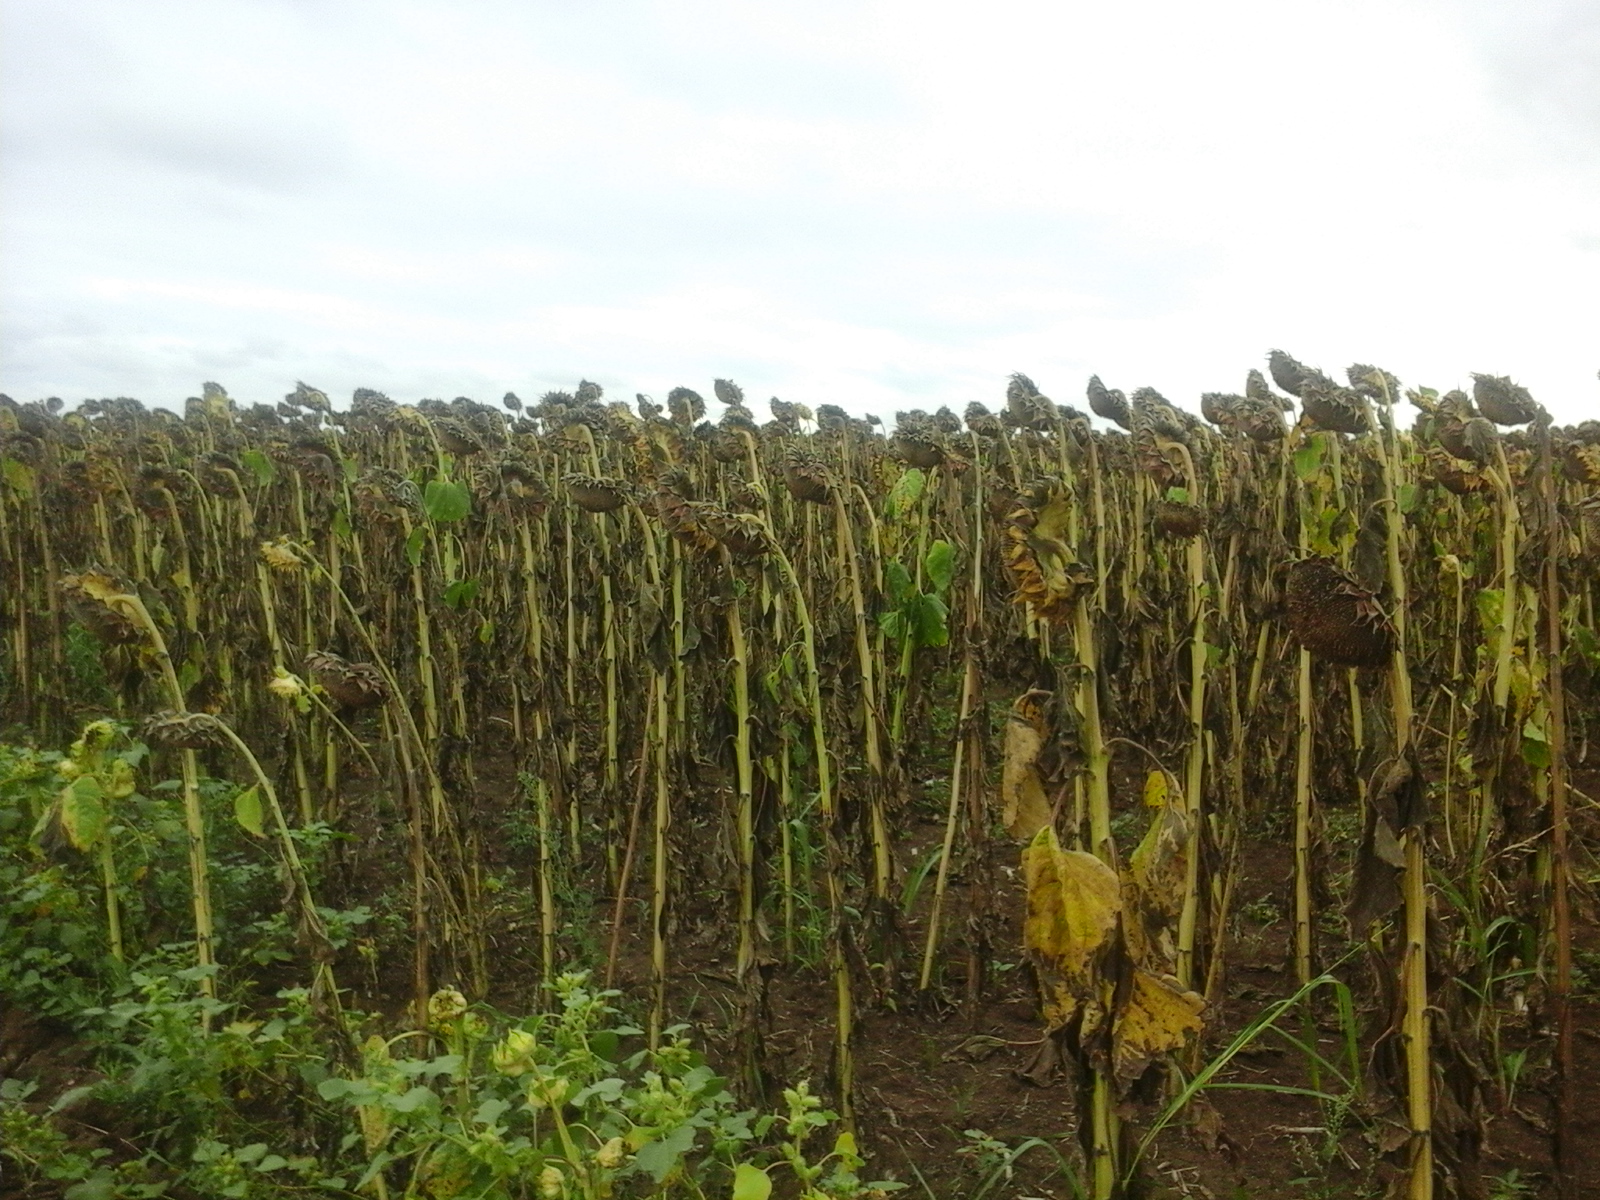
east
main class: Cropland
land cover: Sunflower
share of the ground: > 75 %
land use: Agriculture (excluding fallow land and kitchen gardens)
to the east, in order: Sunflower; Grass margins; Tracks; Spontaneously vegetated surfaces; Inland fresh running water; Abandoned hedges; Other bare soil
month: September
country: RO
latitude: 47.2108
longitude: 21.9165
